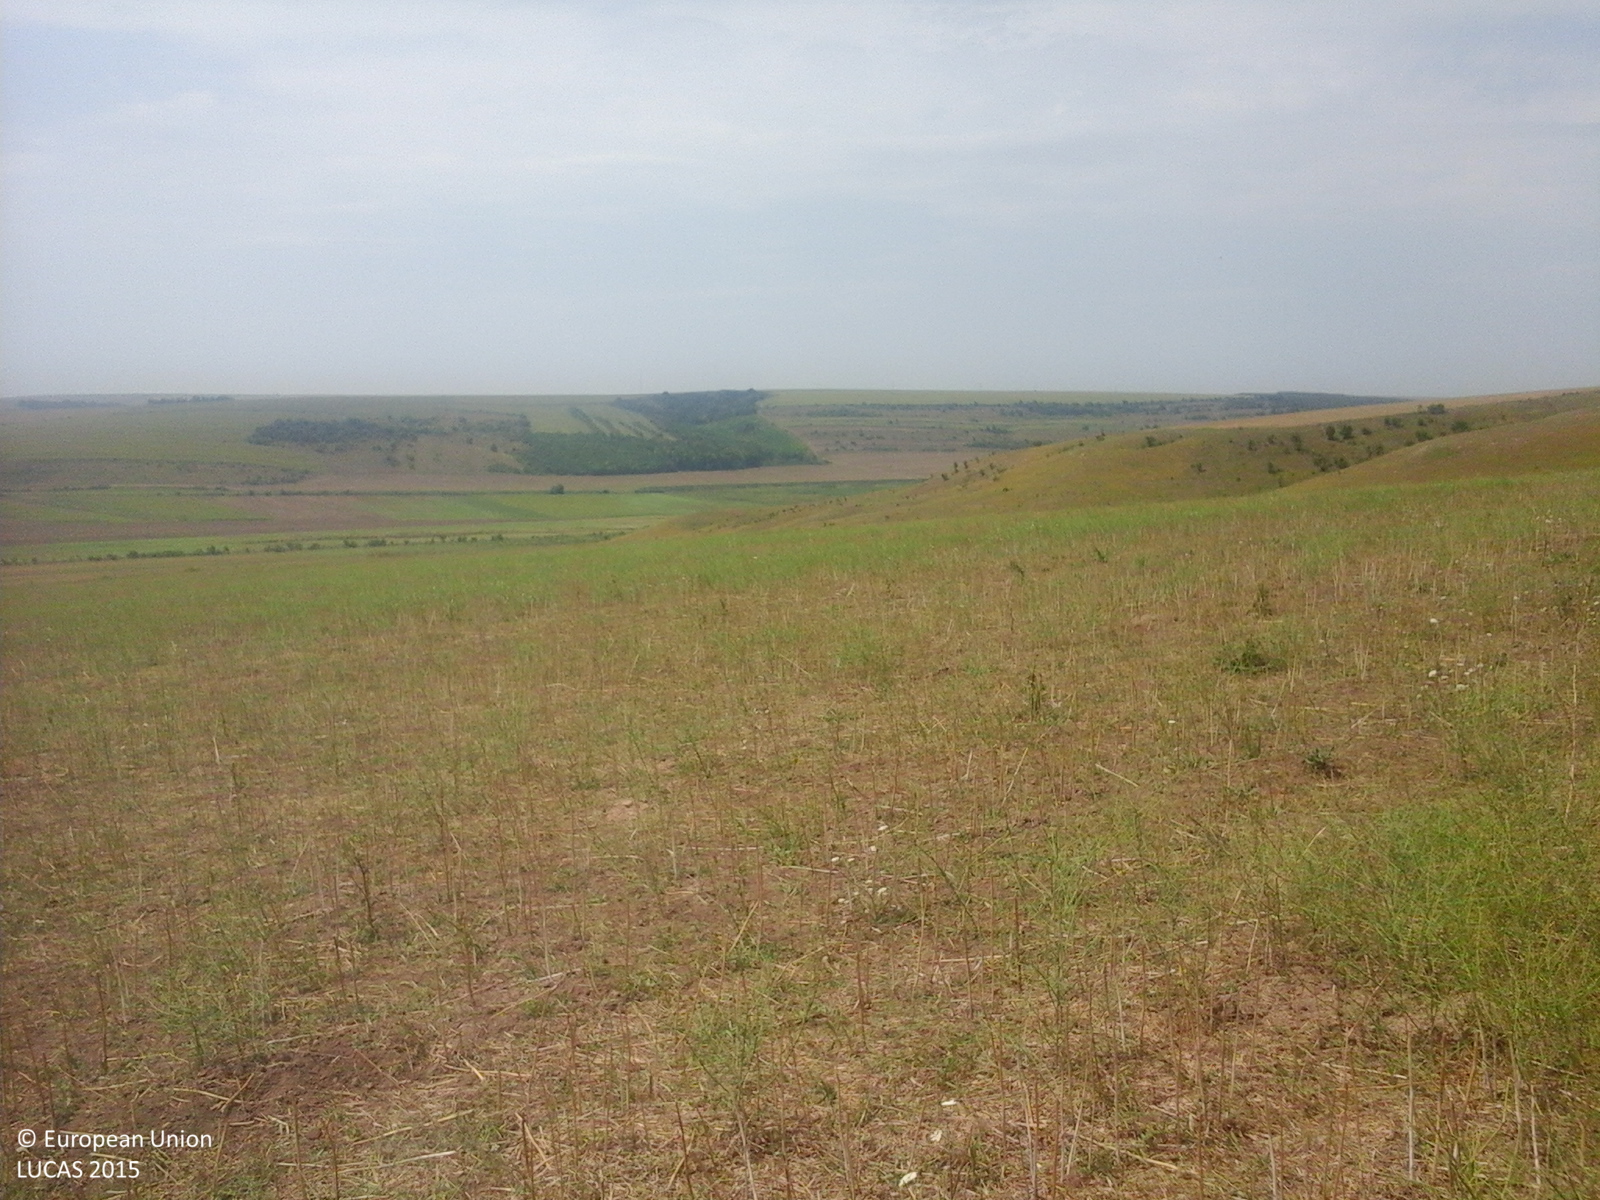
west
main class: Cropland
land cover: Rape and turnip rape
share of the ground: 25 - 50 %
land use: Agriculture (excluding fallow land and kitchen gardens)
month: August
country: RO
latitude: 44.0401
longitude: 27.8561
